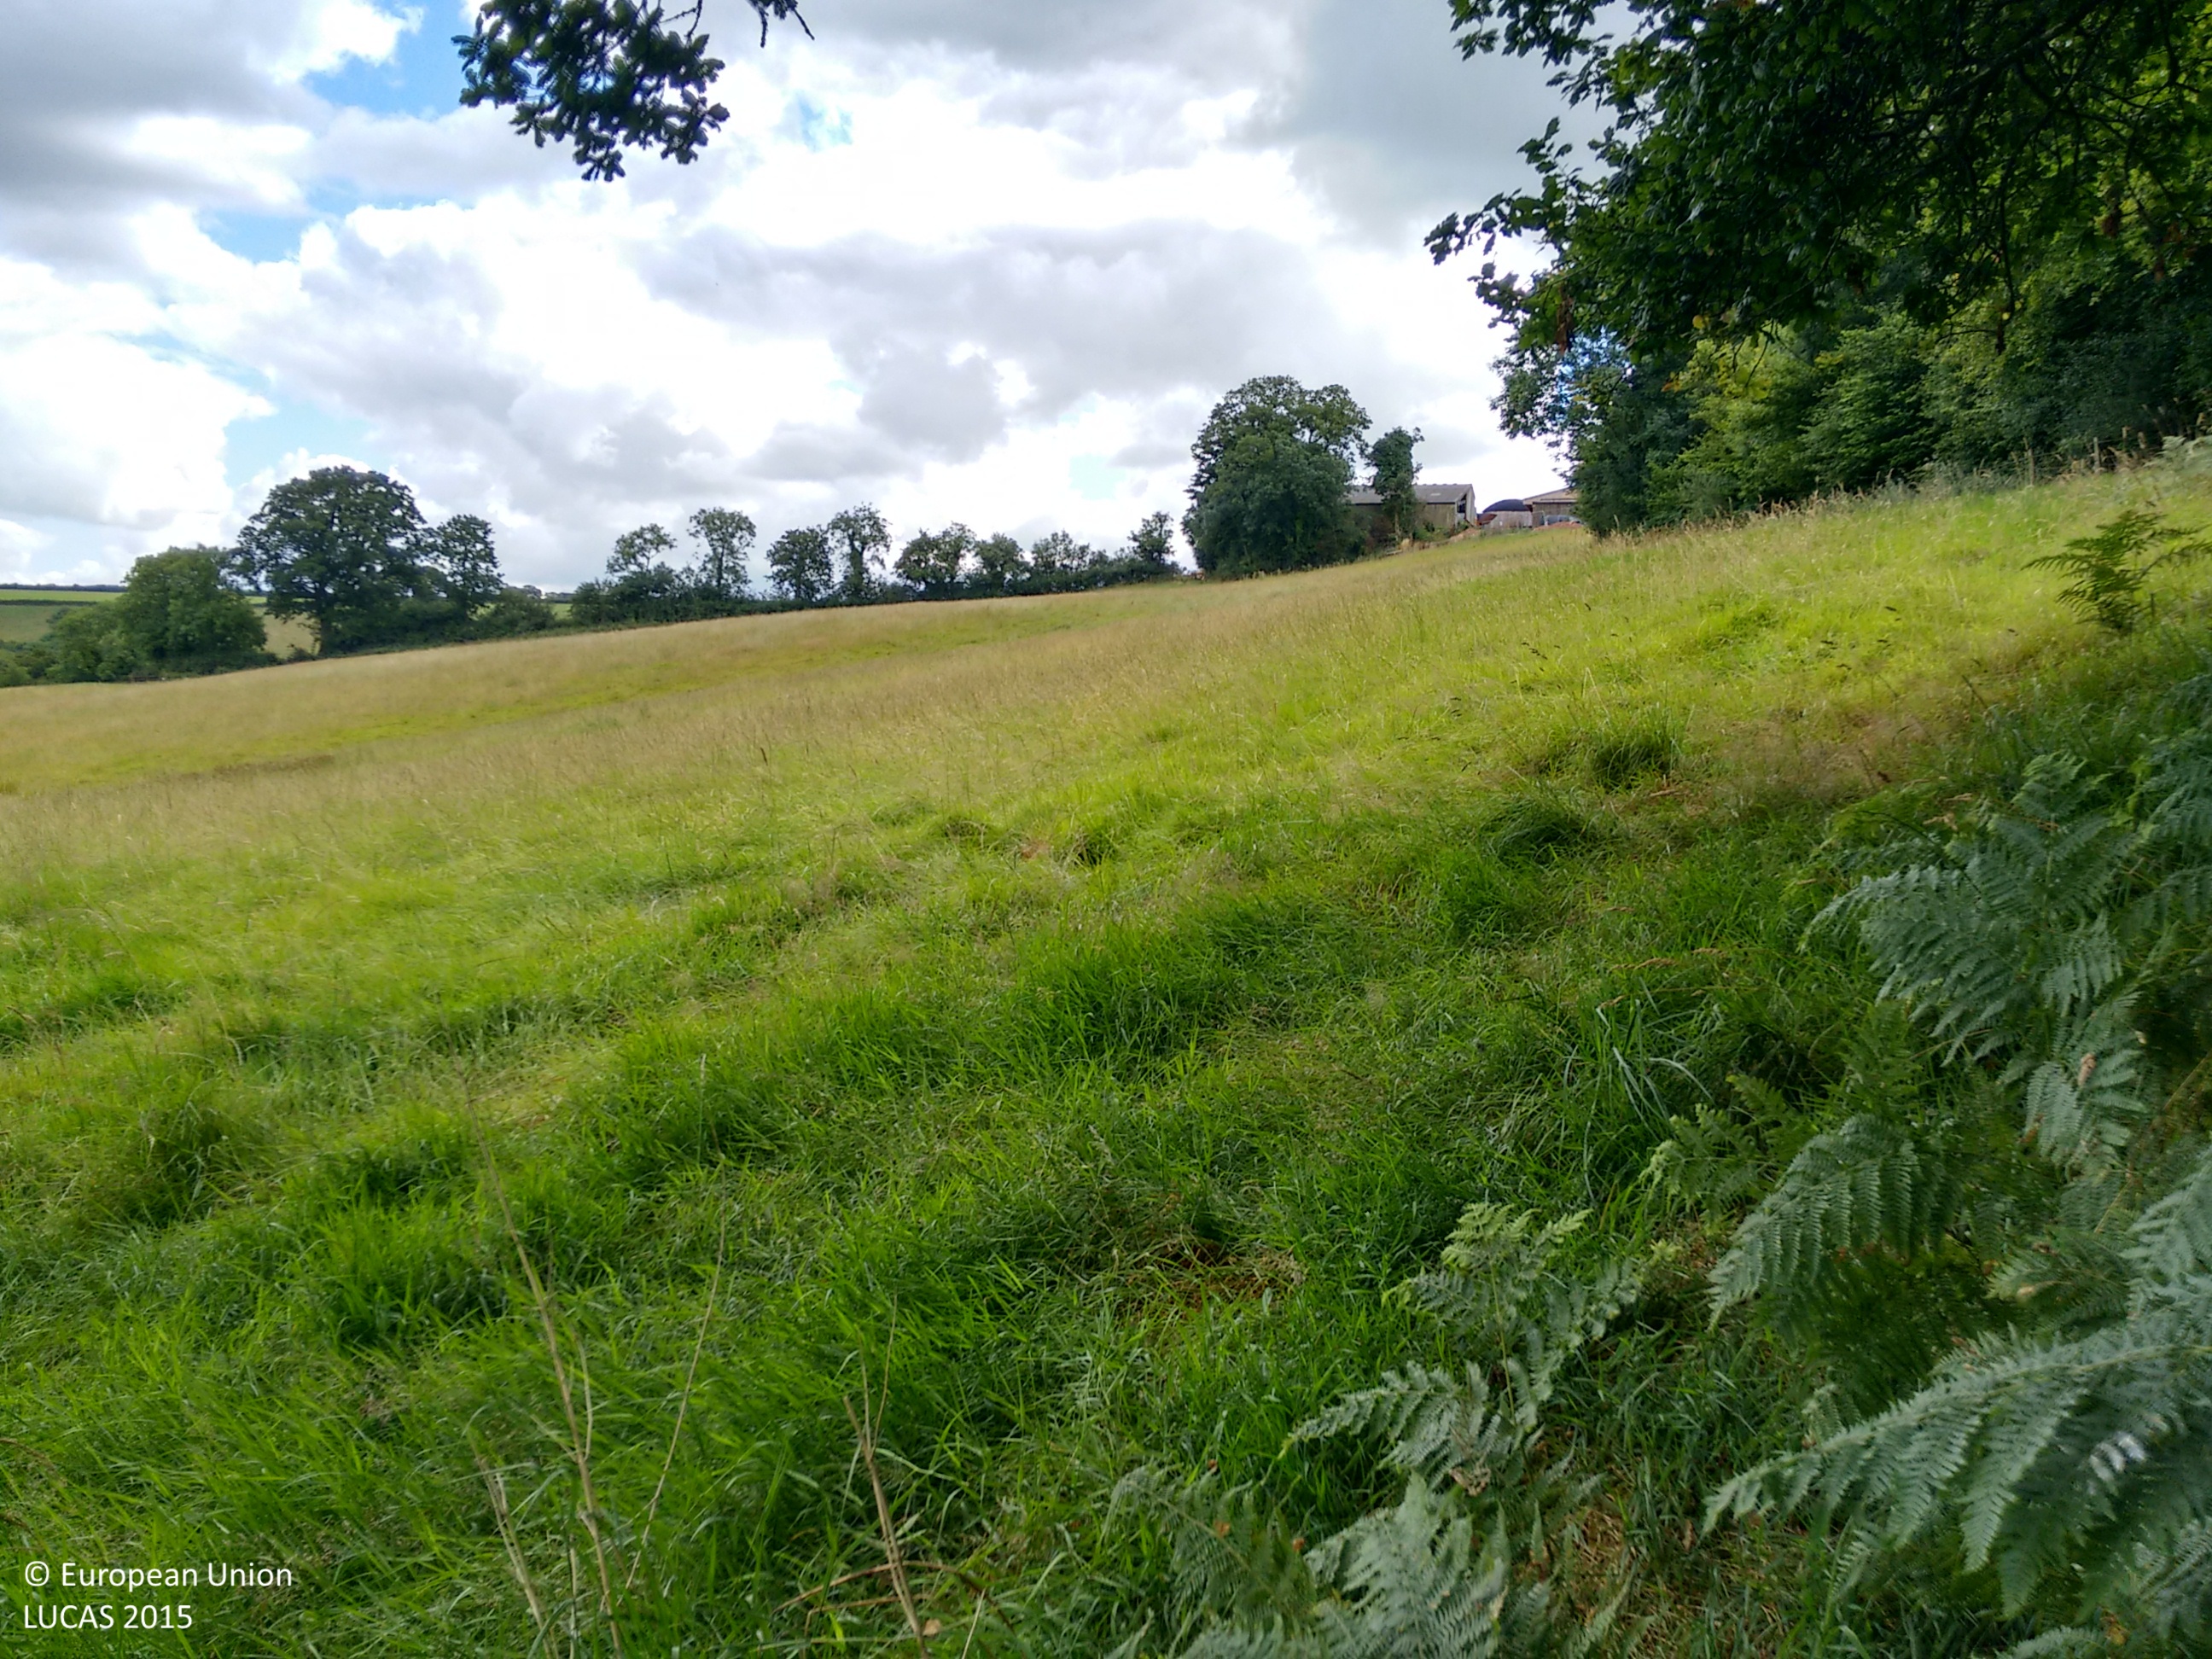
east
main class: Woodland
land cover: Broadleaved woodland
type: mesophytic deciduous forest
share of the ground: > 75 %
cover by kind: broadleaved forest trees 100 %
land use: Semi-natural and natural areas not in use
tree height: > 5 m
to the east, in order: Broadleaved woodland; Fences; Grassland without tree/shrub cover; Fences; Broadleaved woodland; Artificial constructions in urban areas; Other bare soil
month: August
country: GB
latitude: 50.8739
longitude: -3.4849
